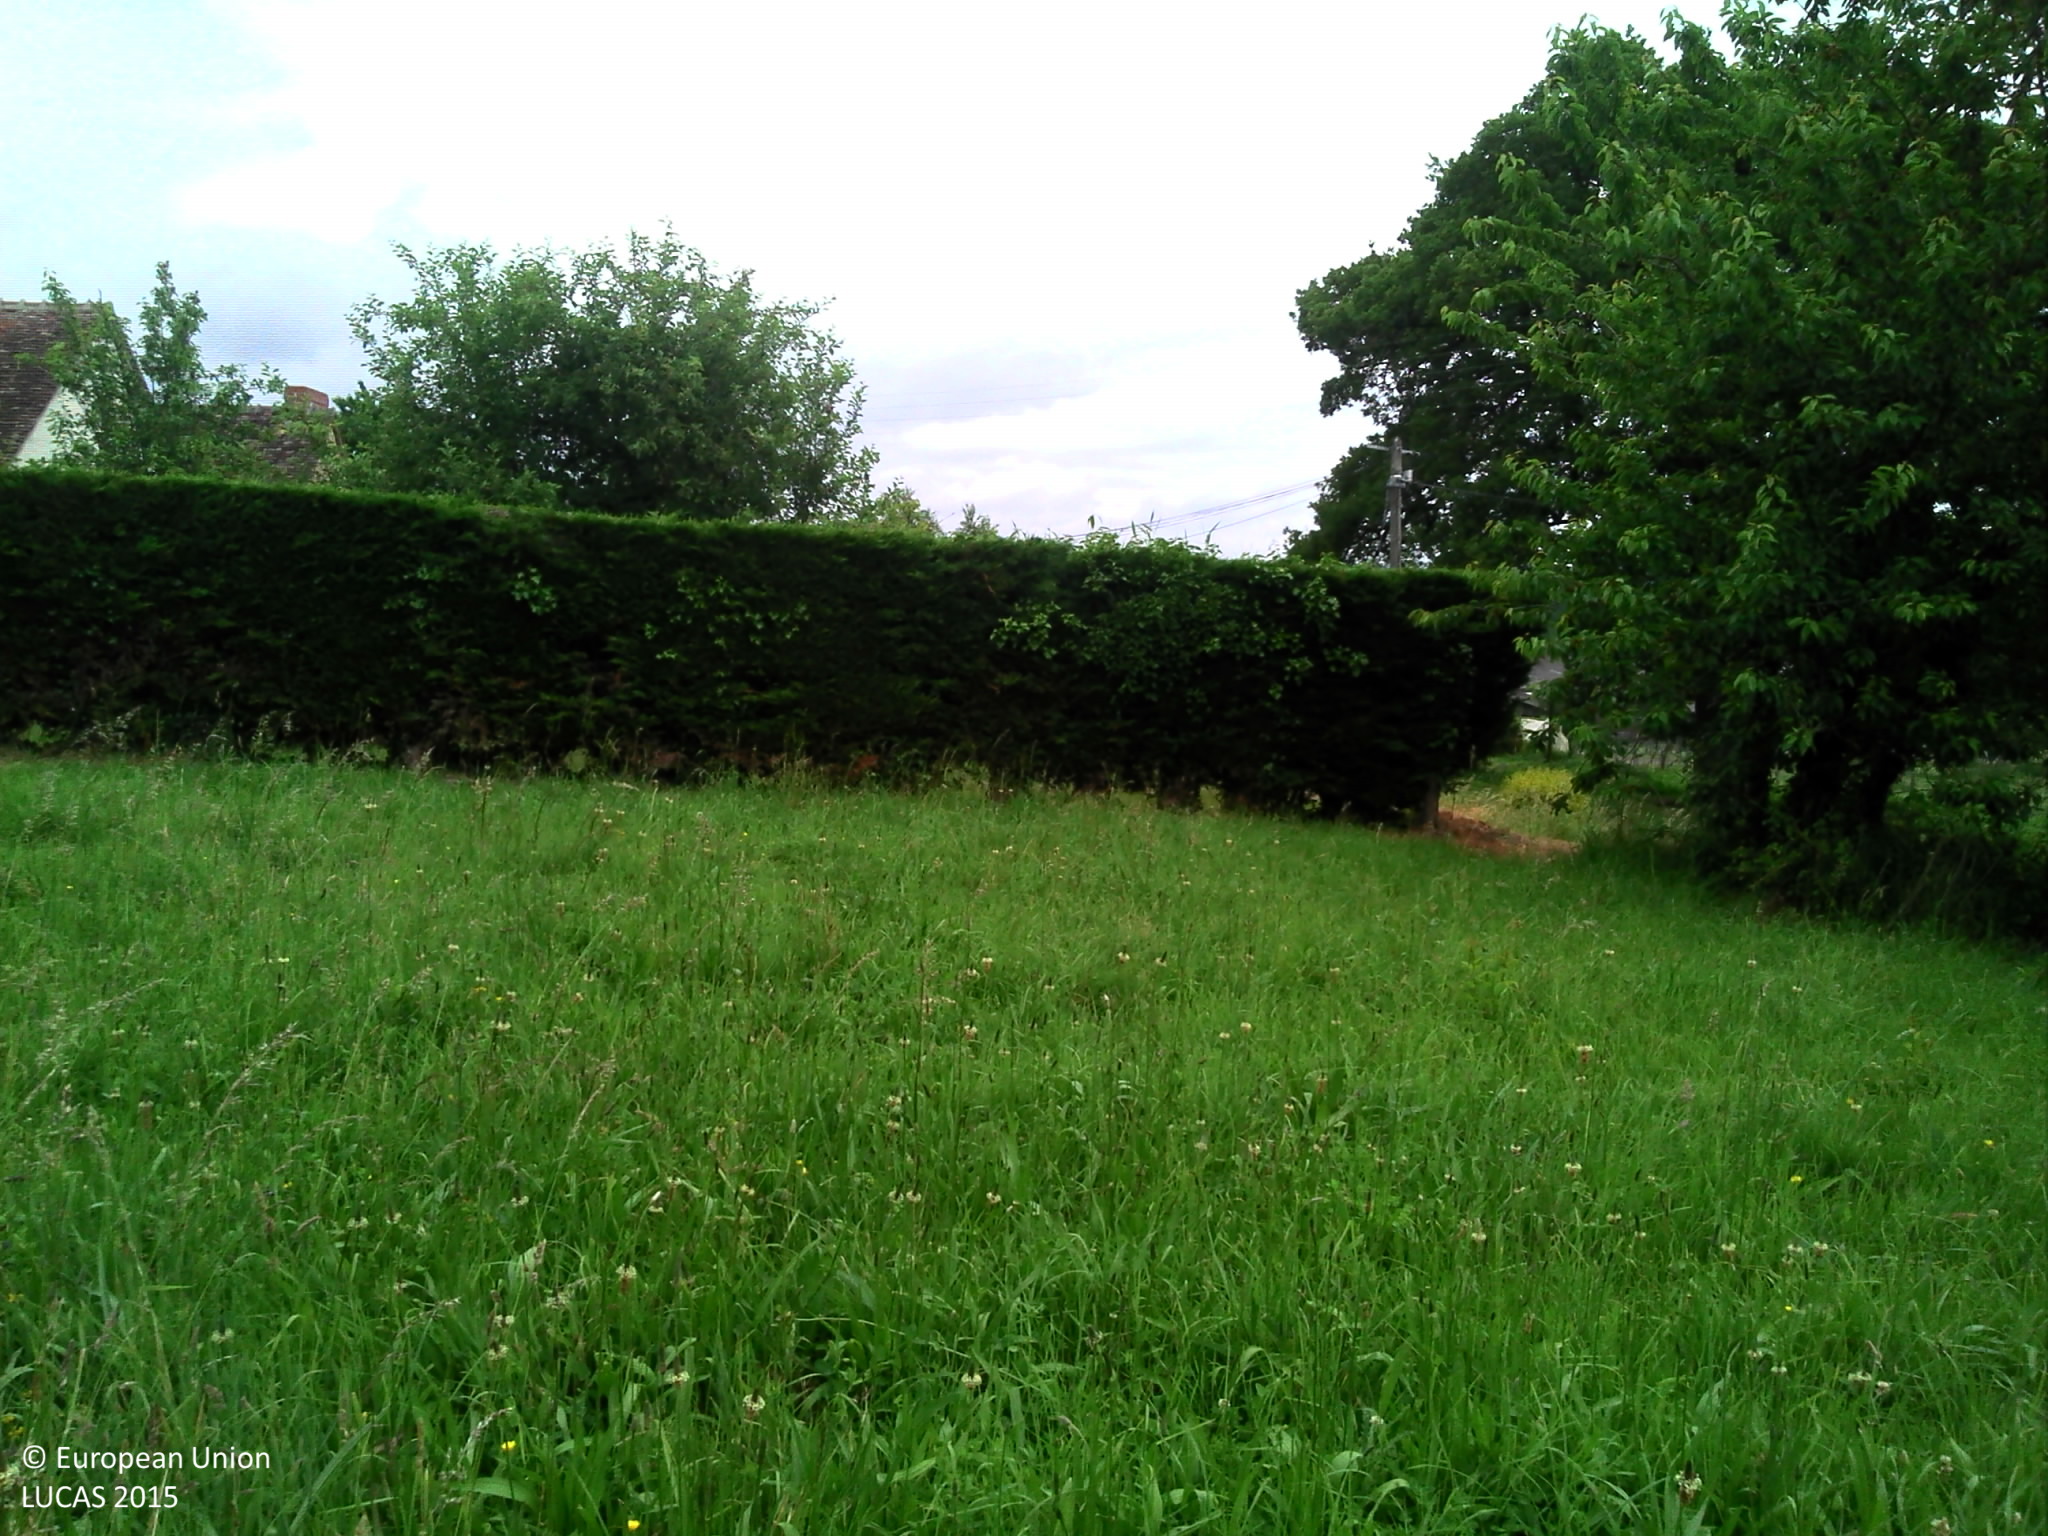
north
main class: Grassland
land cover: Grassland without tree/shrub cover
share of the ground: > 75 %
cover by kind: herbaceous plants 100 %
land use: Agriculture (excluding fallow land and kitchen gardens)
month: June
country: FR
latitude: 46.7363
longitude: 0.8364
